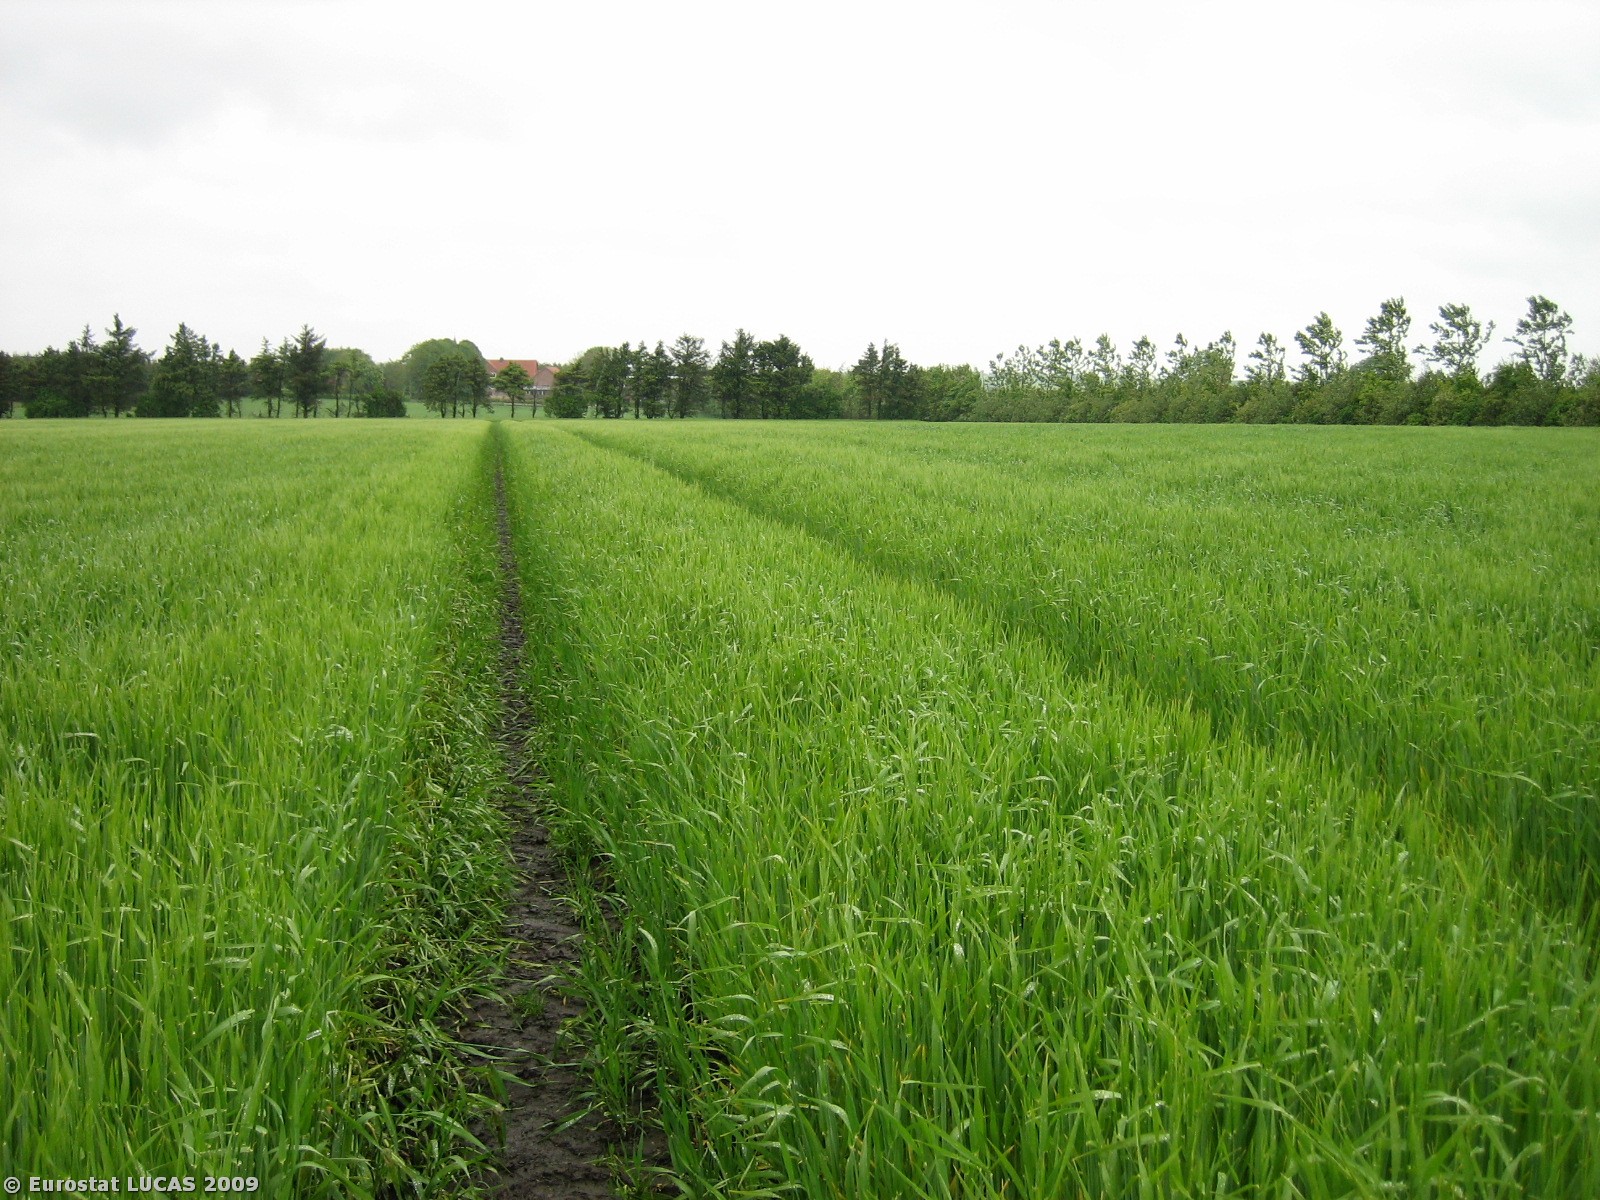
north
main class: Cropland
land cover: Barley
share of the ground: > 75 %
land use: Agriculture (excluding fallow land and kitchen gardens)
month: May
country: DK
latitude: 56.0532
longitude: 8.5083
